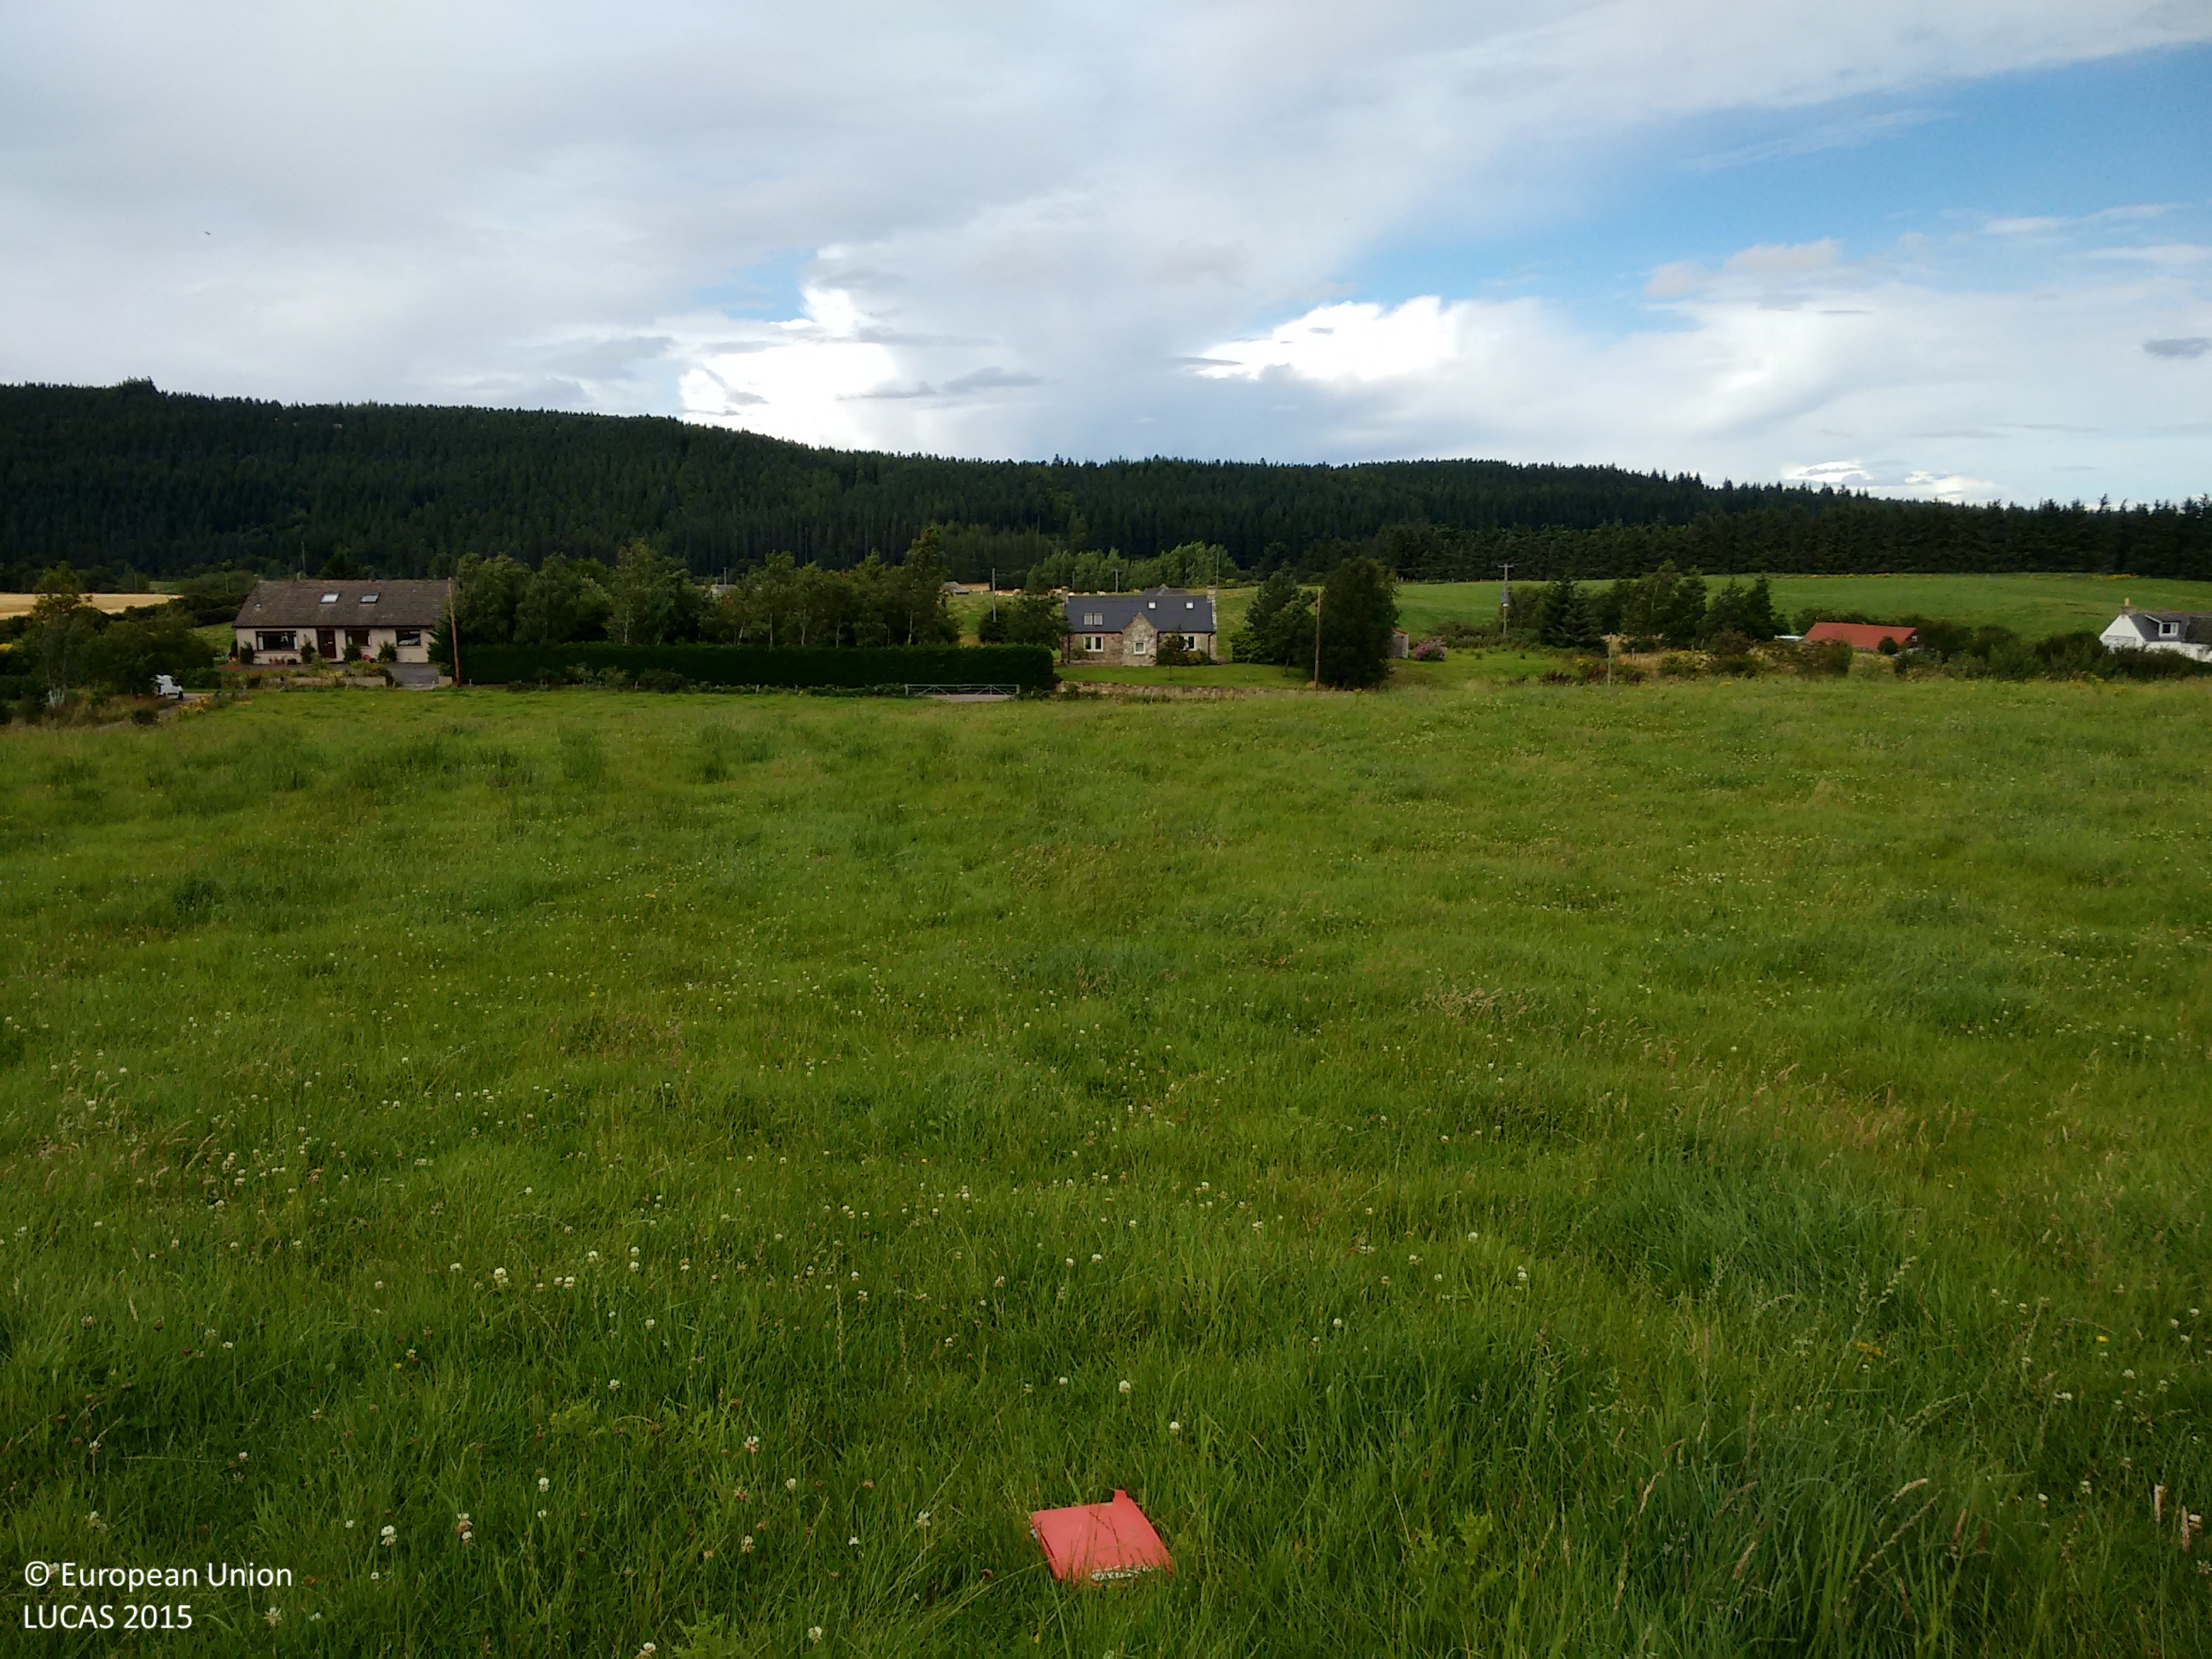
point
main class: Grassland
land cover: Grassland without tree/shrub cover
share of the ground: > 75 %
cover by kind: herbaceous plants 100 %
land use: Agriculture (excluding fallow land and kitchen gardens)
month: August
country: GB
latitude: 57.5988
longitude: -3.4038
